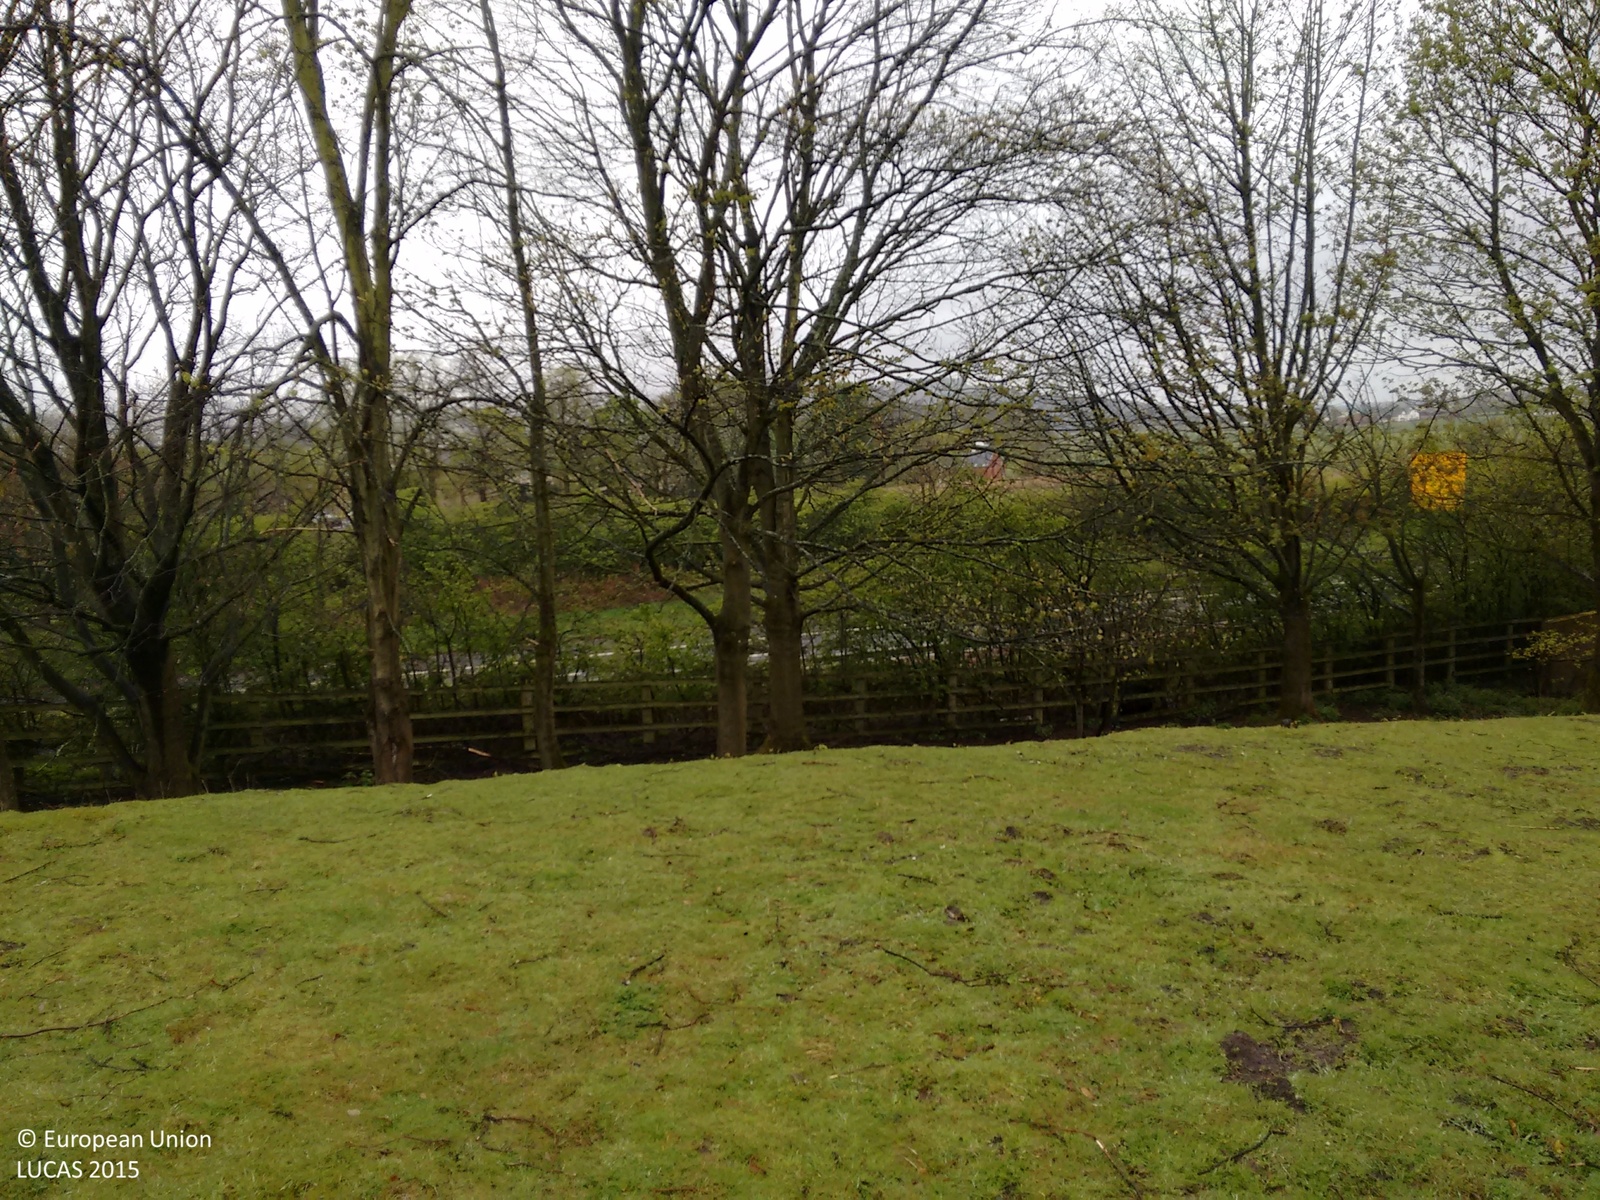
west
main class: Grassland
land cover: Grassland without tree/shrub cover
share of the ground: > 75 %
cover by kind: herbaceous plants 95 %, lichens and mosses 5 %
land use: Road transport
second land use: Residential
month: May
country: GB
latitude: 56.1136
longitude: -3.9648
